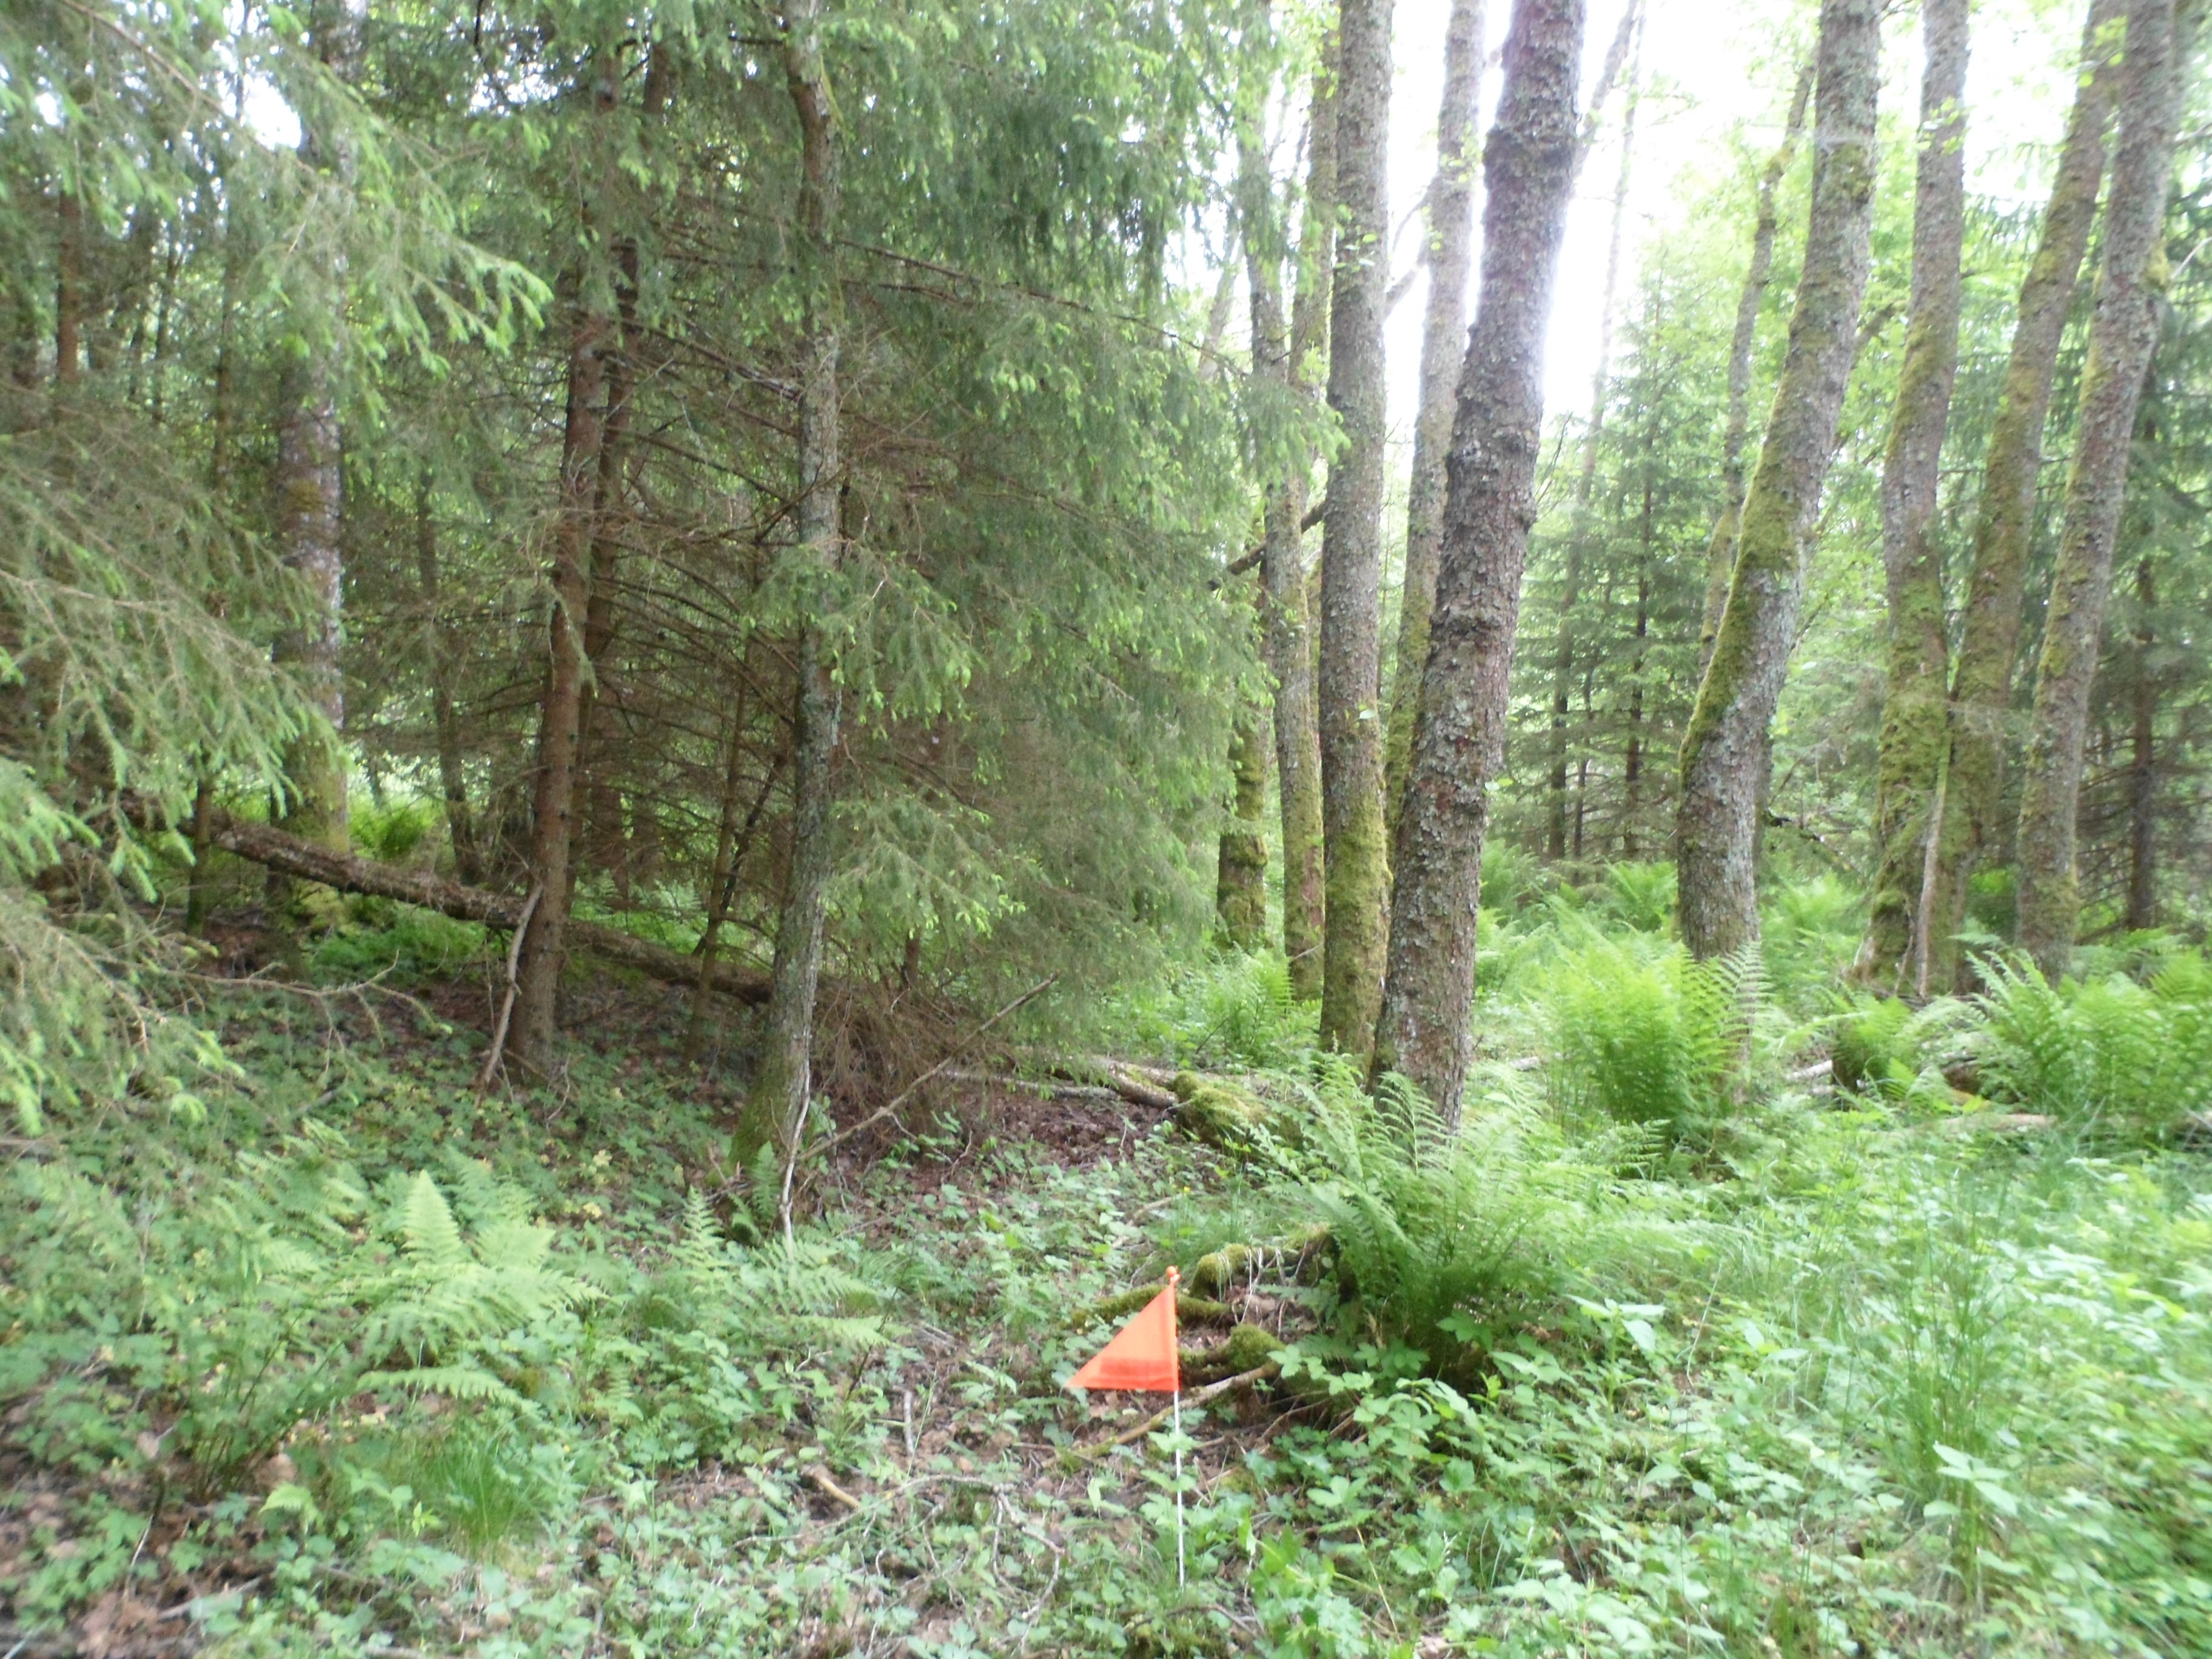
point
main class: Woodland
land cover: Spruce dominated mixed woodland
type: boreal forest
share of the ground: 50 - 75 %
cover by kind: broadleaved forest trees 45 %, coniferous forest trees 30 %, herbaceous plants 15 %, shrubs 5 %, lichens and mosses 5 %
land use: Forestry
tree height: > 5 m
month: June
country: SE
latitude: 56.9547
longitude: 14.5184
